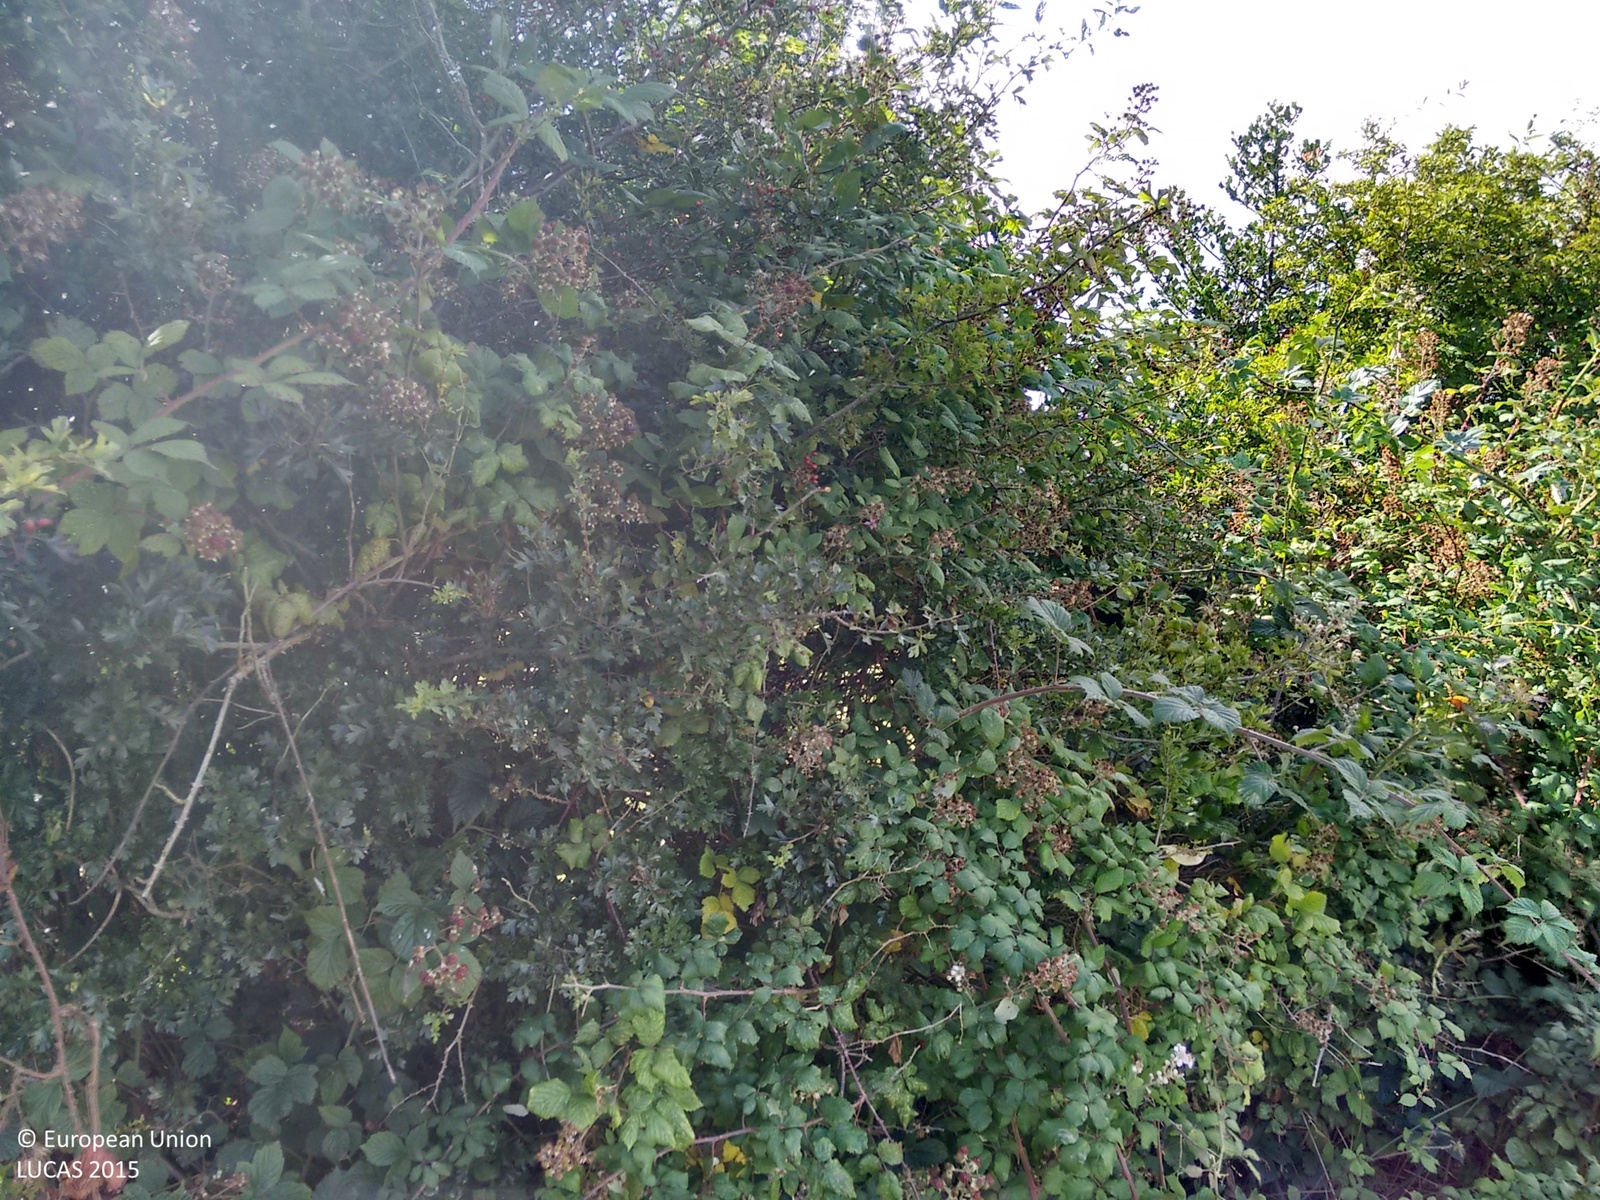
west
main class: Grassland
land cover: Grassland without tree/shrub cover
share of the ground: > 75 %
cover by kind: herbaceous plants 95 %, shrubs 5 %
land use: Agriculture (excluding fallow land and kitchen gardens)
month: August
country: IE
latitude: 52.1836
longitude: -9.7087
